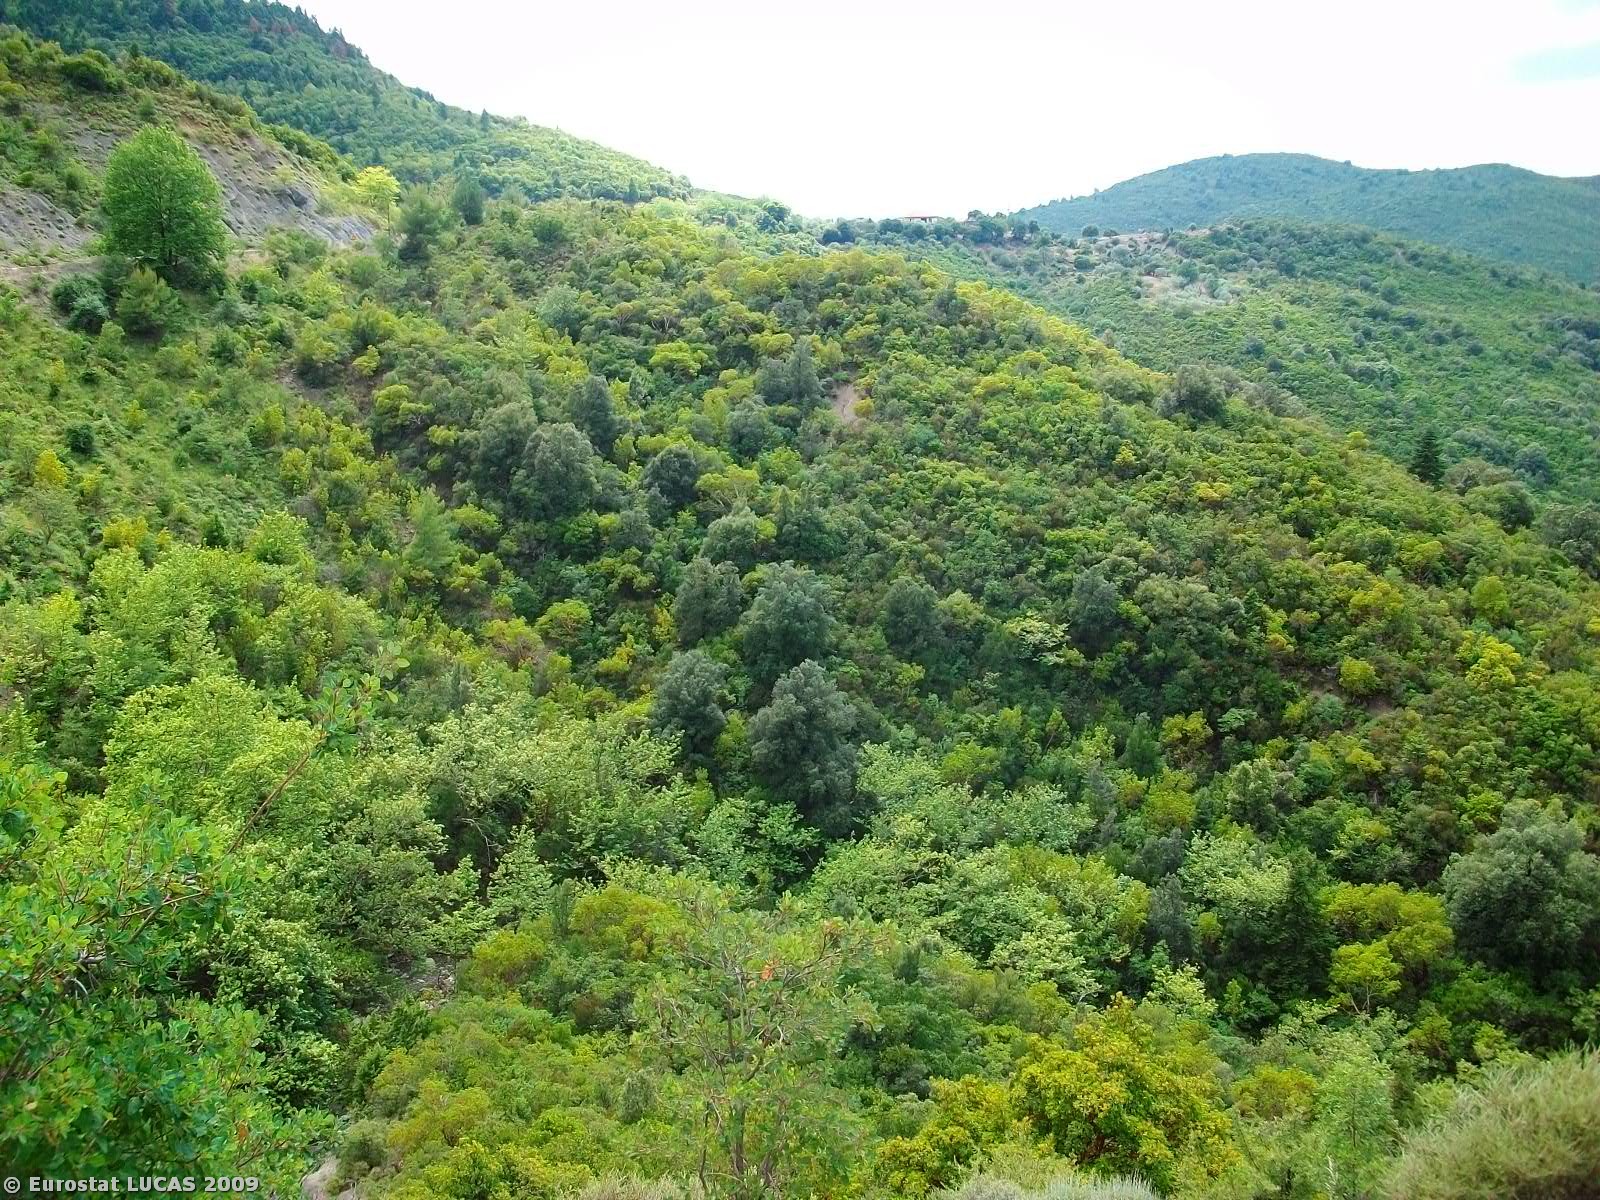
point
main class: Woodland
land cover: Broadleaved woodland
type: thermophilous deciduous forest
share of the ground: > 75 %
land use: Forestry
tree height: > 5 m
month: June
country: GR
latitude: 38.8695
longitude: 21.5570
